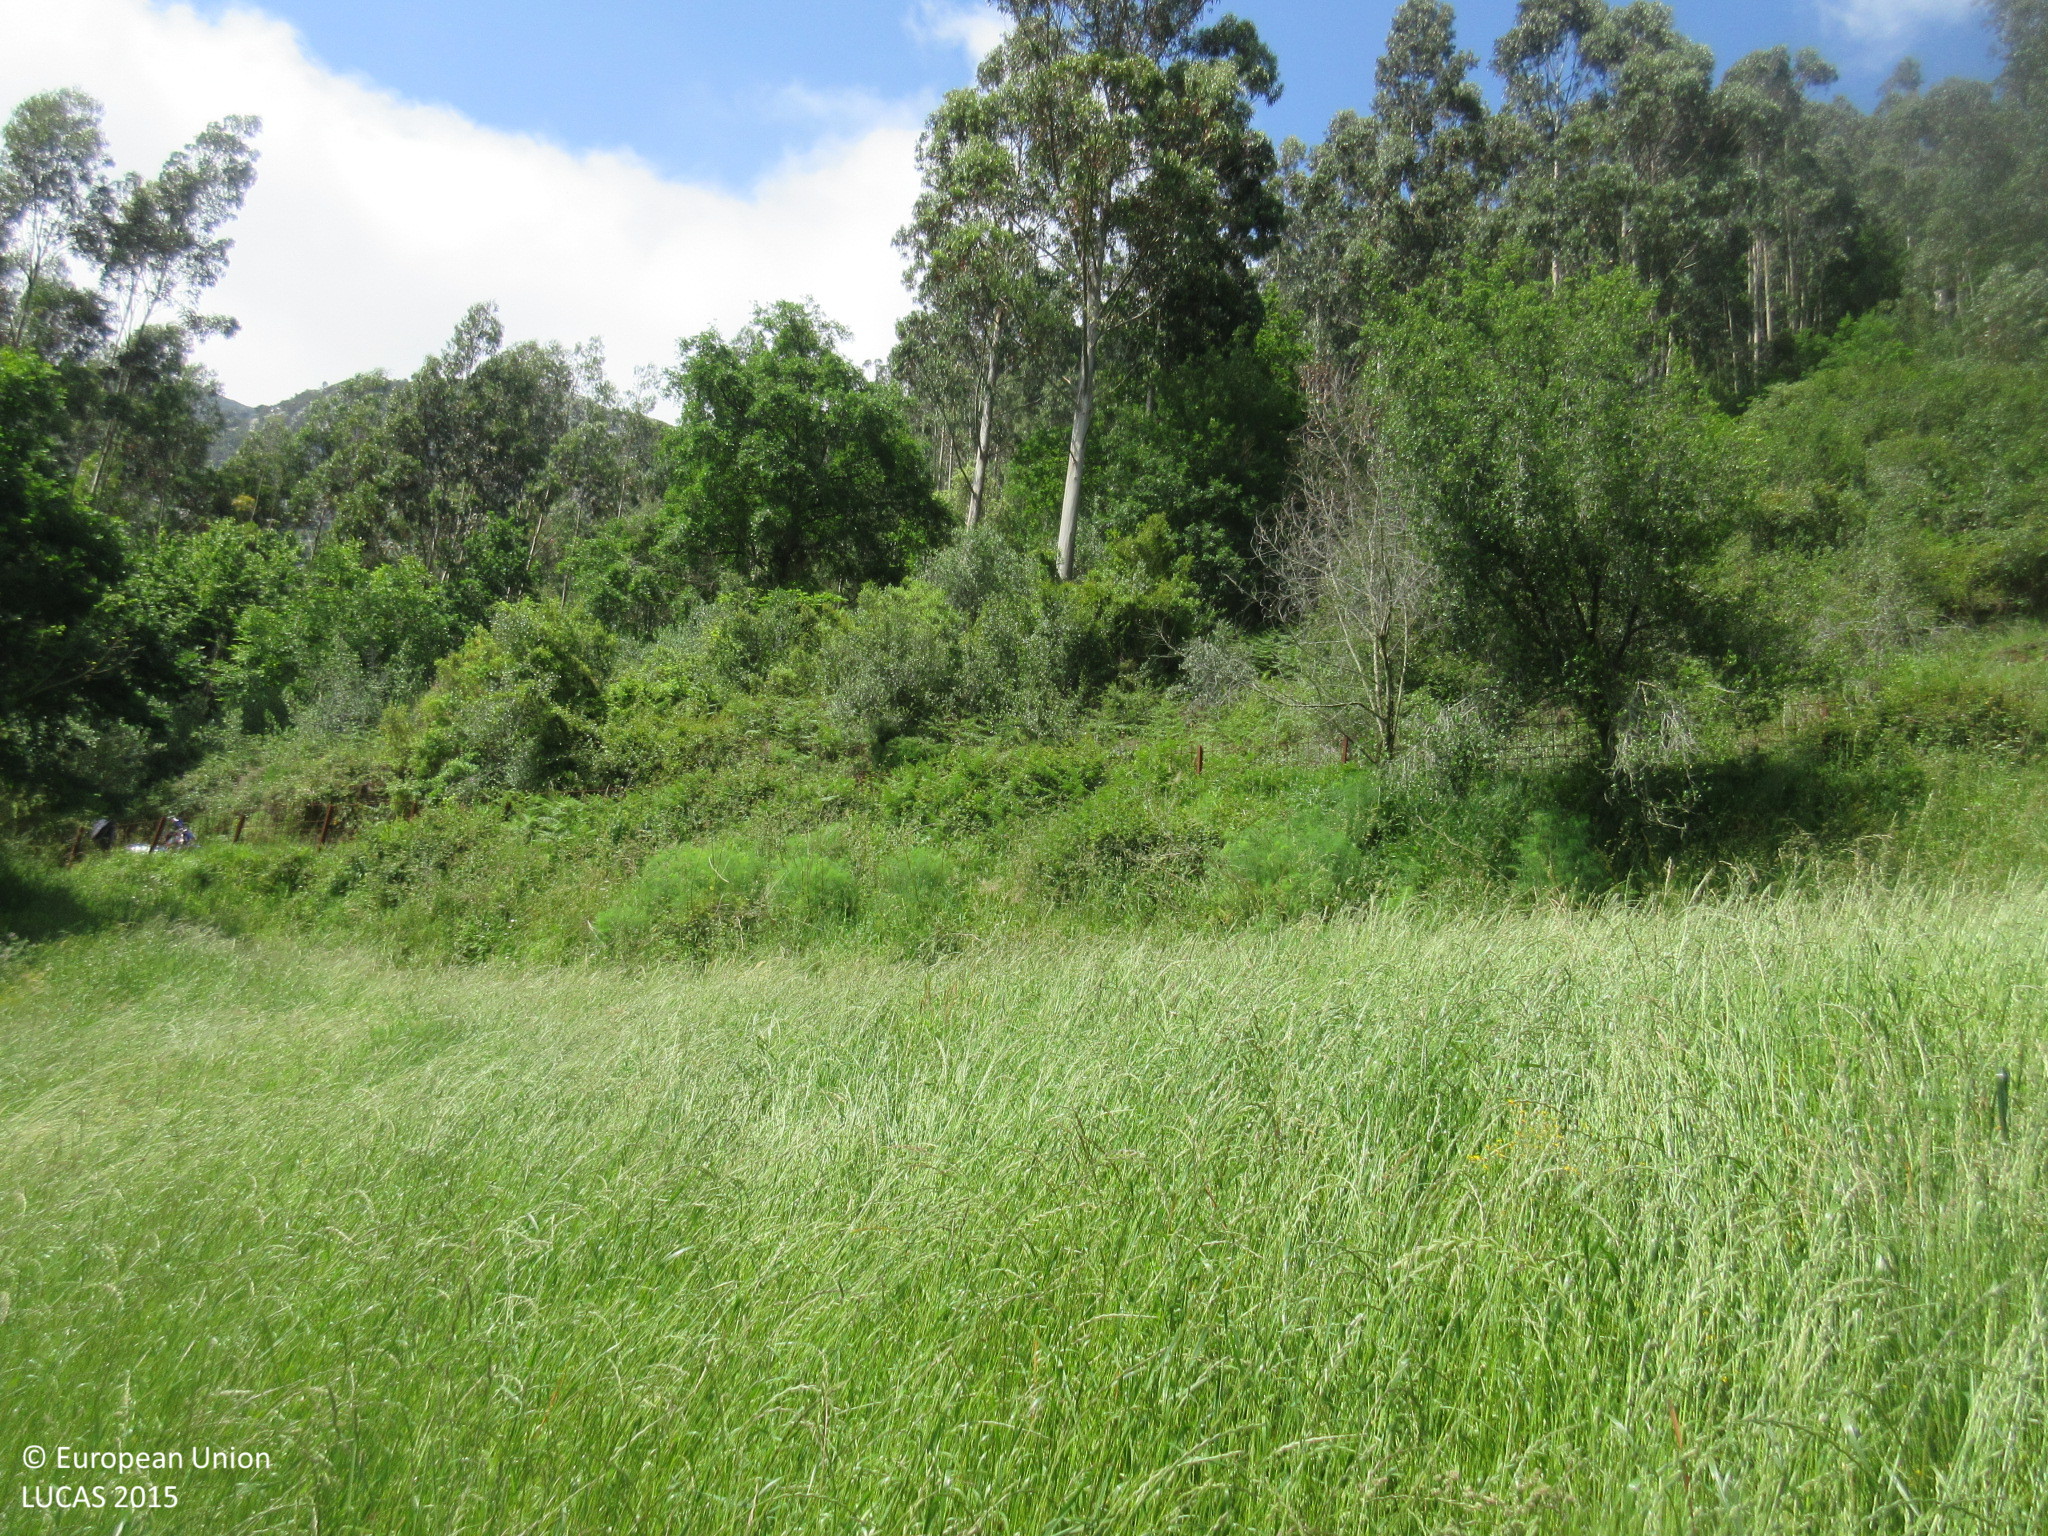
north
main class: Grassland
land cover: Grassland without tree/shrub cover
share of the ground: > 75 %
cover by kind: herbaceous plants 100 %
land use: Agriculture (excluding fallow land and kitchen gardens)
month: May
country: ES
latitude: 43.3329
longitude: -4.5779
